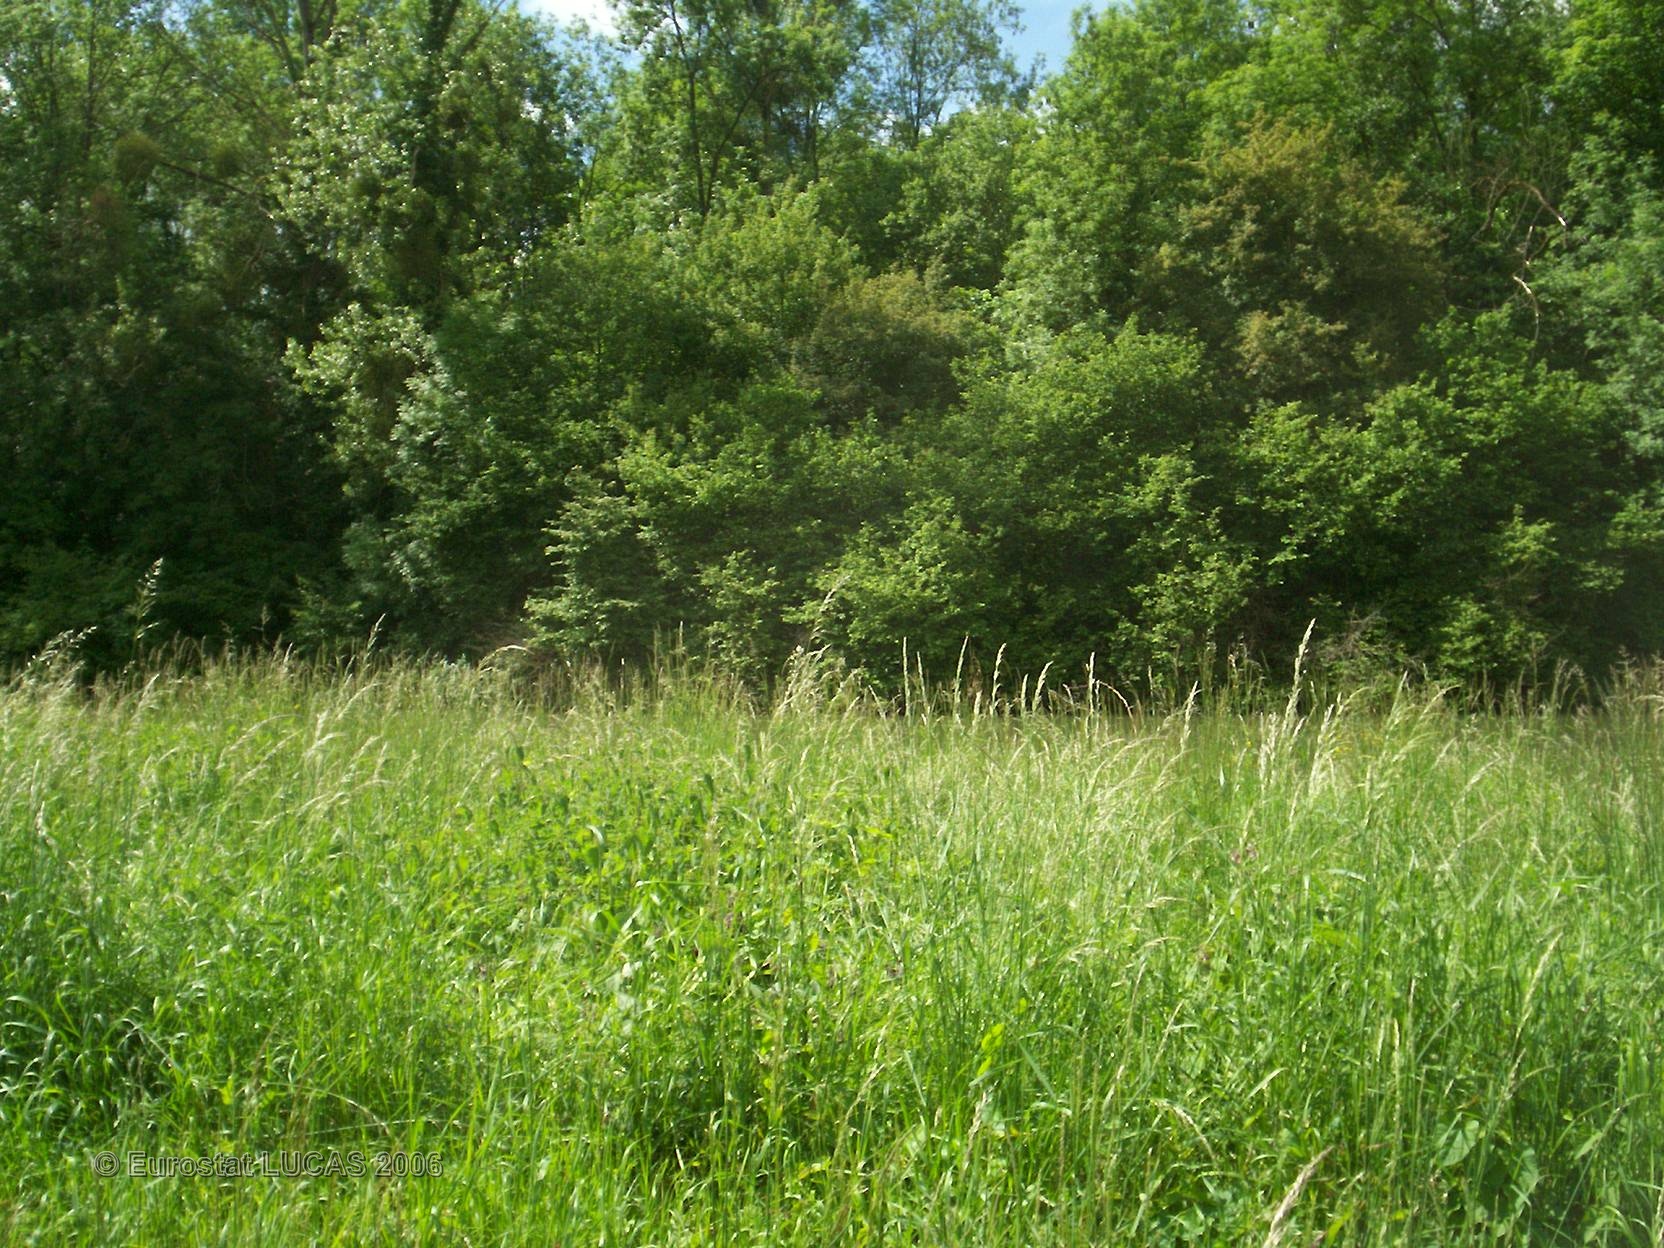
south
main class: Grassland
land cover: Grassland without tree/shrub cover
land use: Agriculture (excluding fallow land and kitchen gardens)
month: May
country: FR
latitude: 49.4881
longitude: 4.4051
